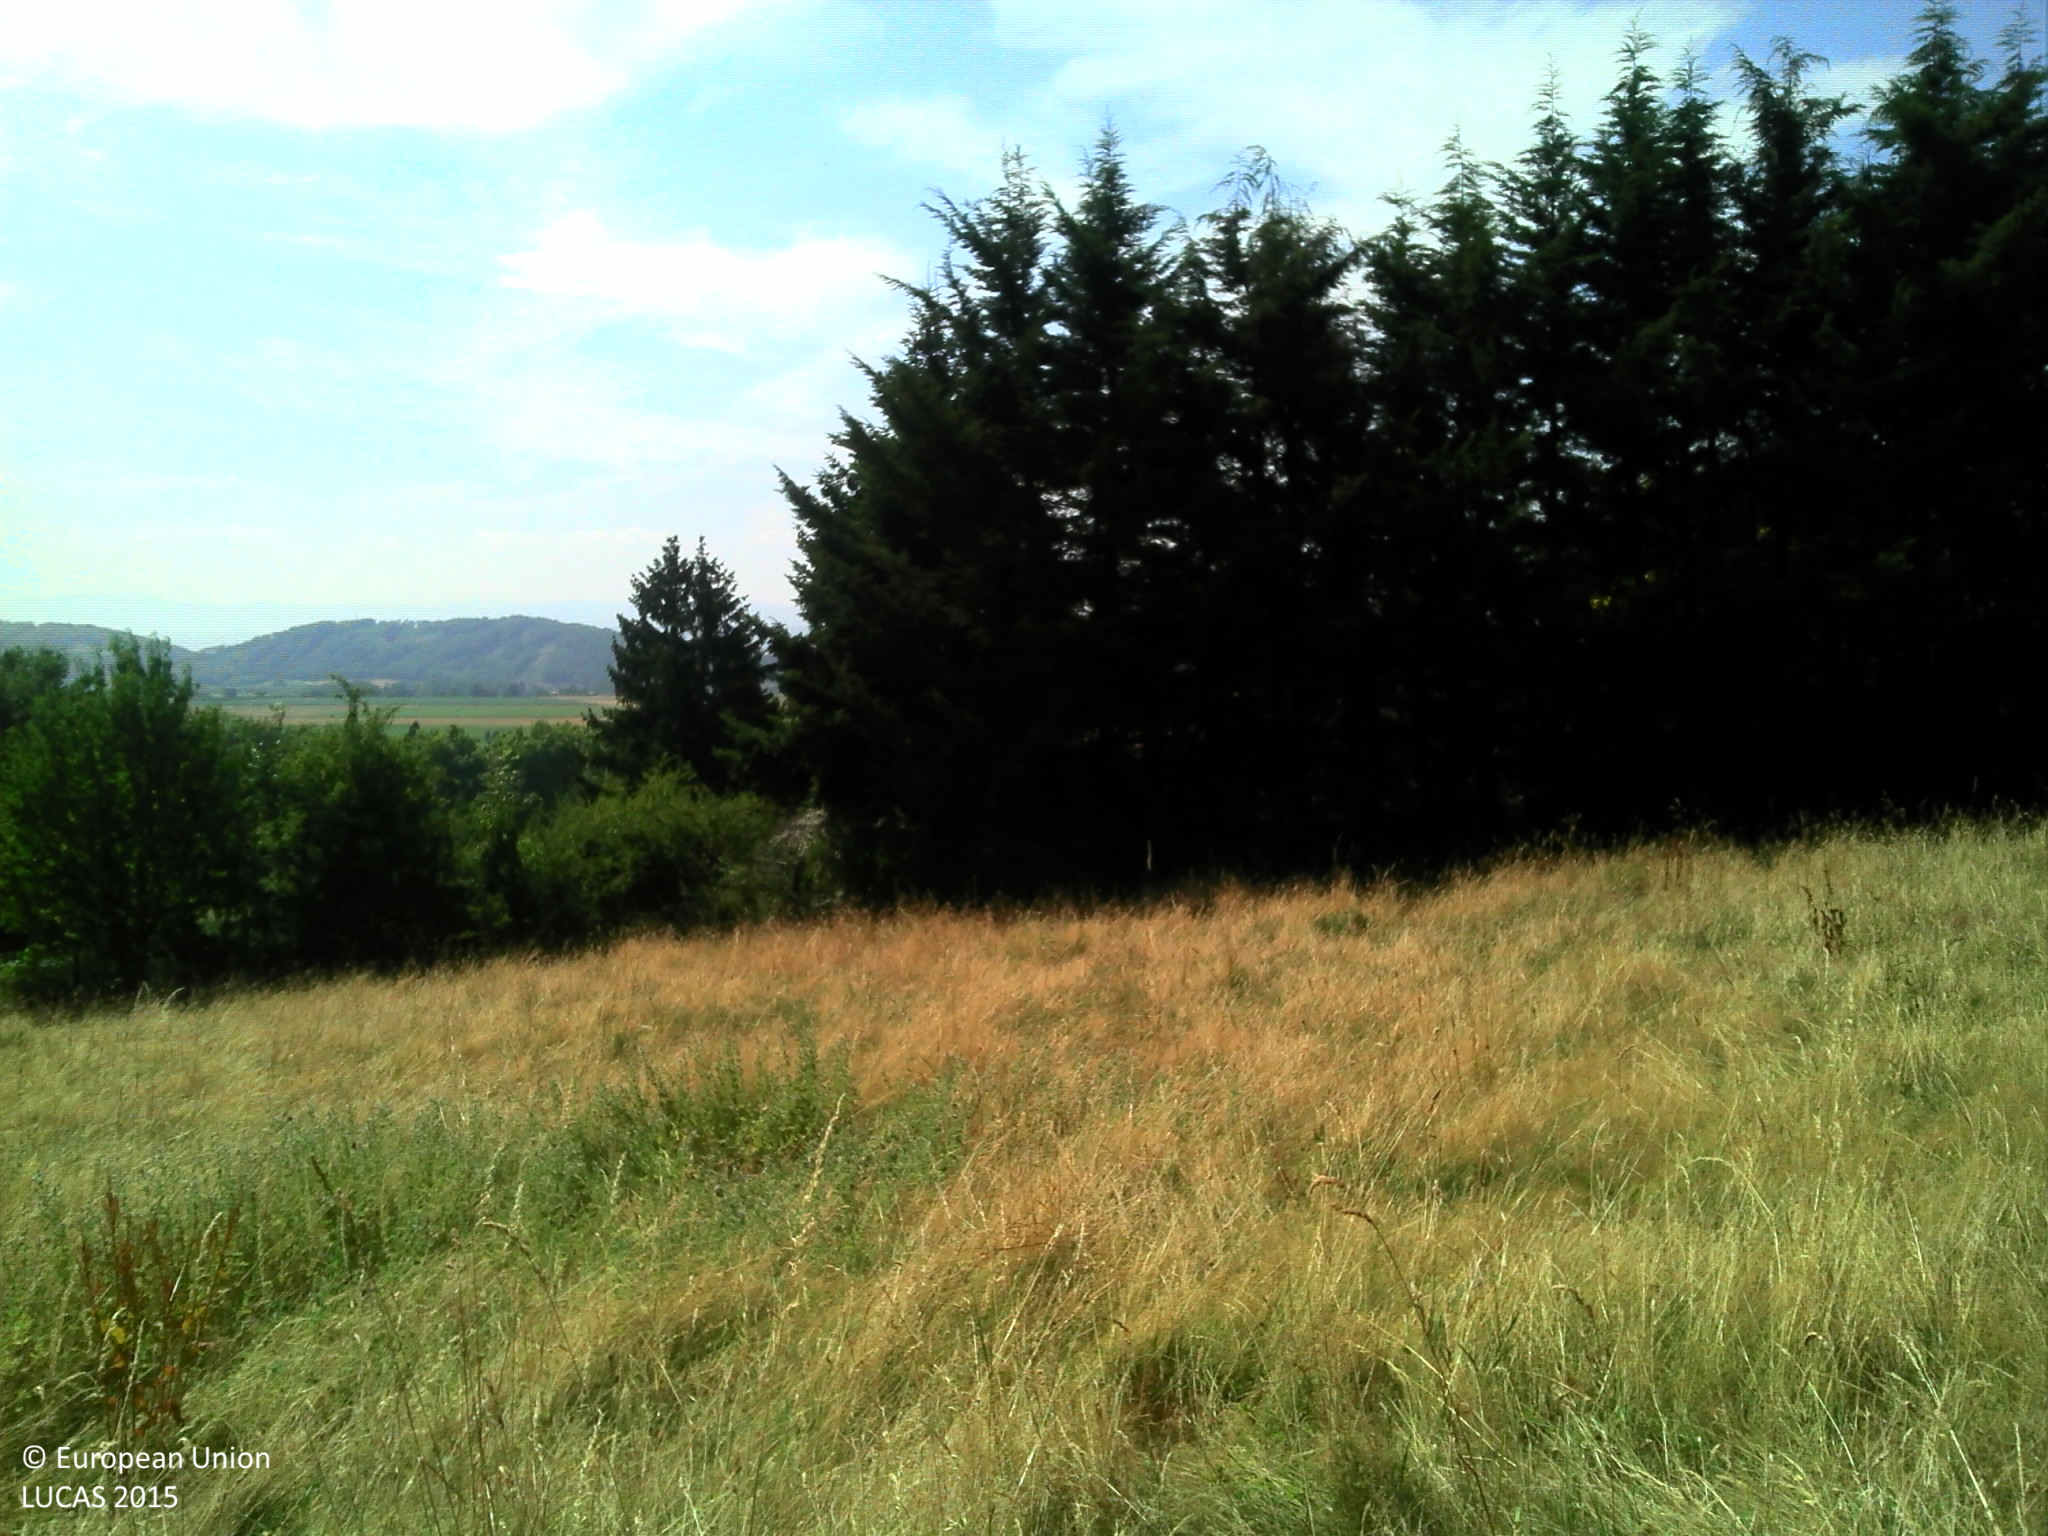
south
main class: Grassland
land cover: Grassland without tree/shrub cover
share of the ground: > 75 %
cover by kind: herbaceous plants 100 %
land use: Agriculture (excluding fallow land and kitchen gardens)
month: July
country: FR
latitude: 45.4307
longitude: 5.1858
